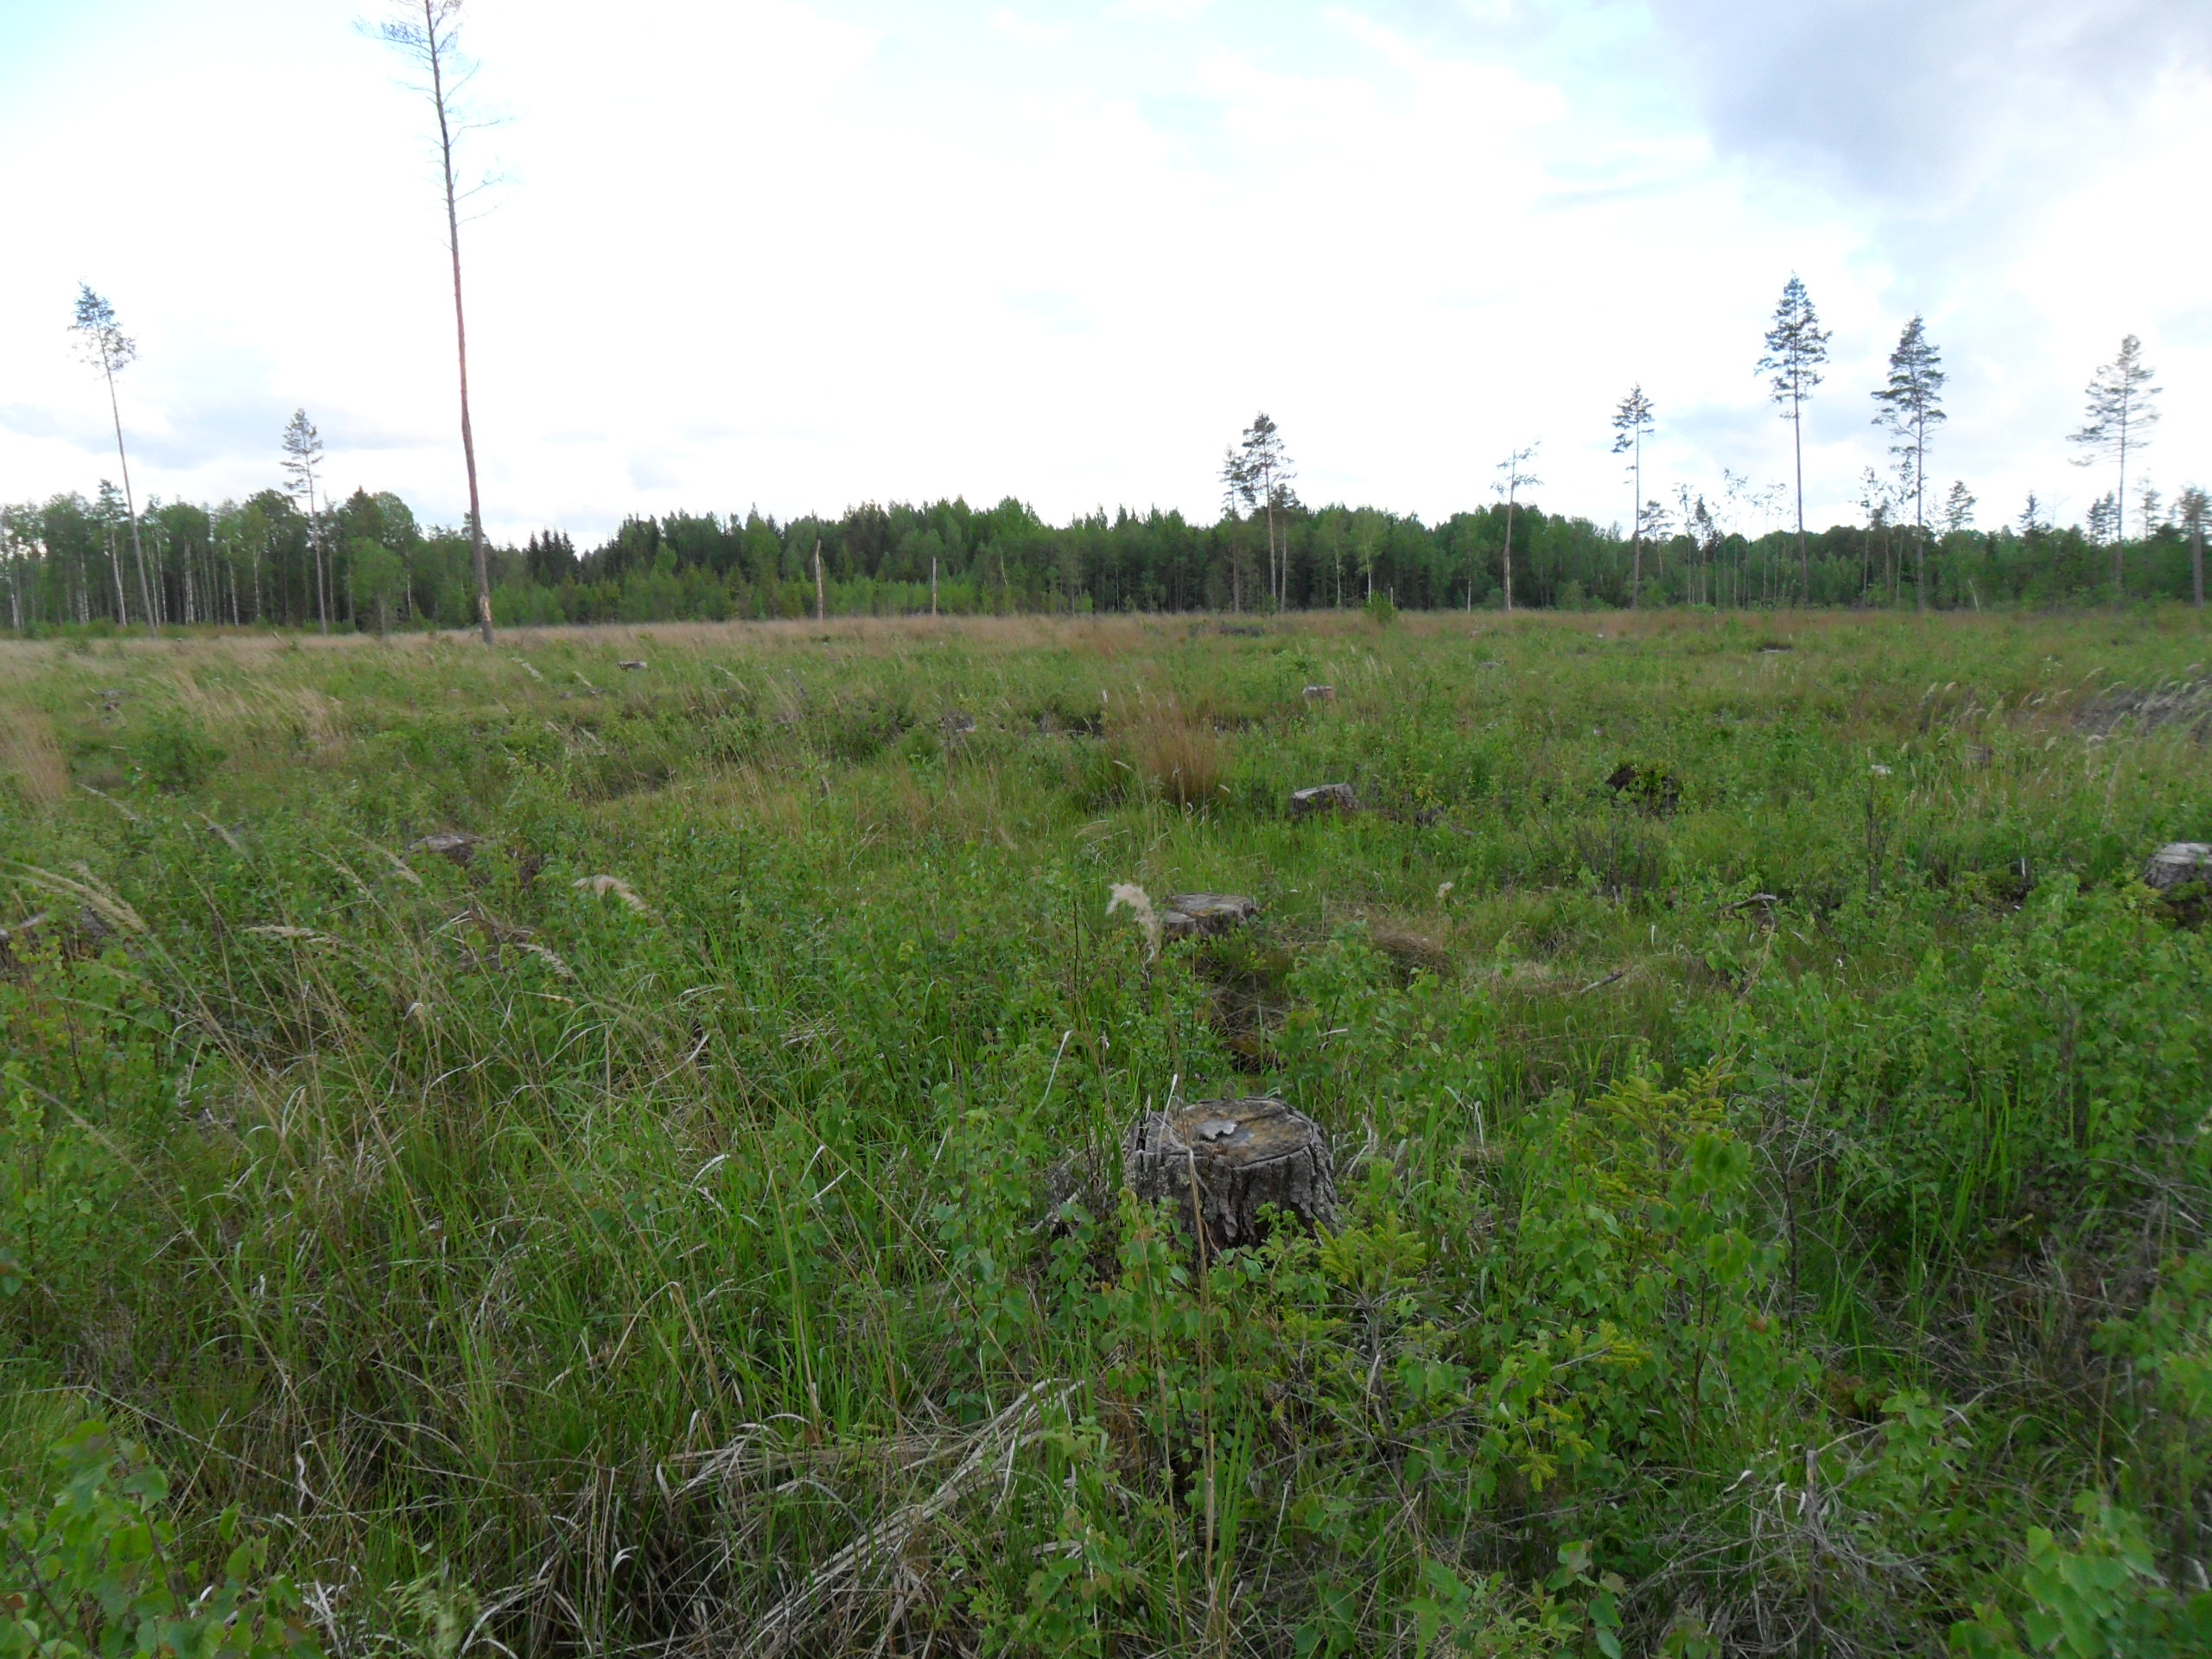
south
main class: Grassland
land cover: Grassland with sparse tree/shrub cover
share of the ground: > 75 %
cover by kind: herbaceous plants 85 %, shrubs 10 %, broadleaved forest trees 5 %
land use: Forestry
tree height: < 5 m
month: June
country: LV
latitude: 57.3093
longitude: 22.4536
